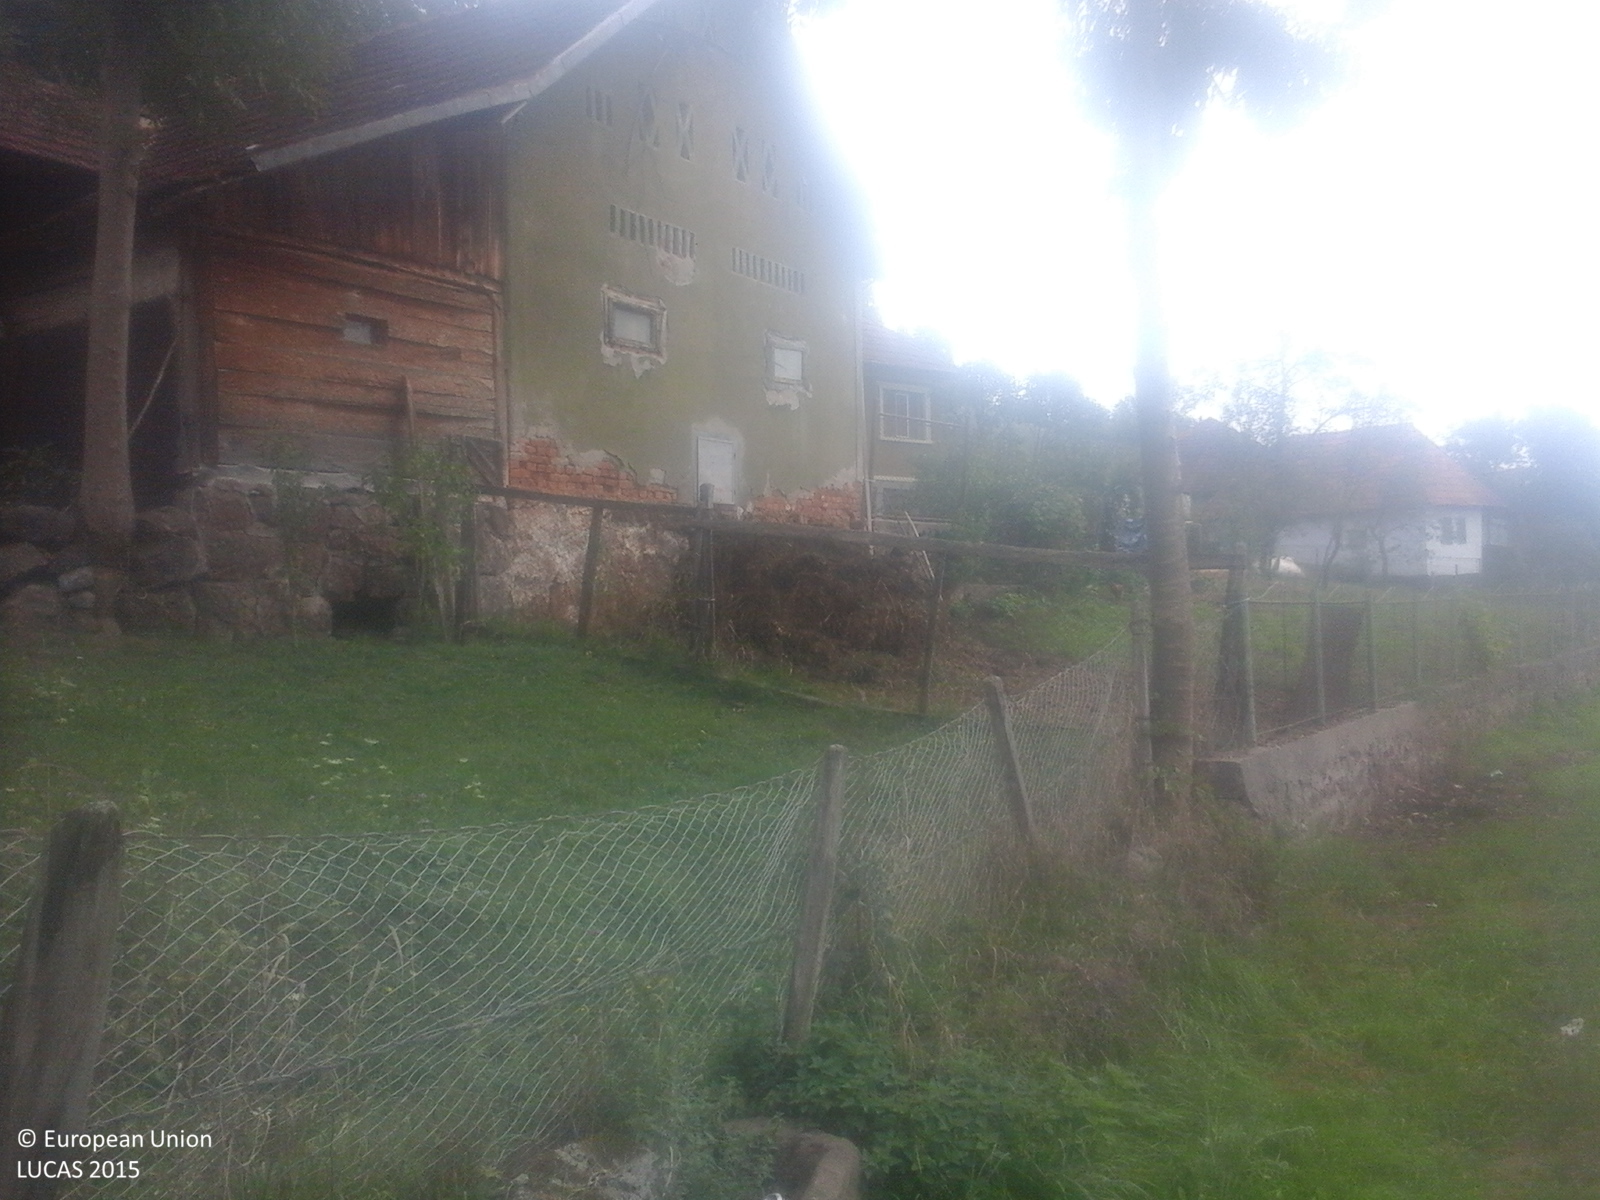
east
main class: Cropland
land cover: Other fruit trees and berries
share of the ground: 50 - 75 %
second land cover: Grassland without tree/shrub cover
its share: > 75 %
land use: Agriculture (excluding fallow land and kitchen gardens)
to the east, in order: Other fruit trees and berries; Grassland without tree/shrub cover; Broadleaved woodland; Grassland without tree/shrub cover; Broadleaved woodland; Grassland without tree/shrub cover
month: September
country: RO
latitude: 46.0565
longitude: 22.9161
